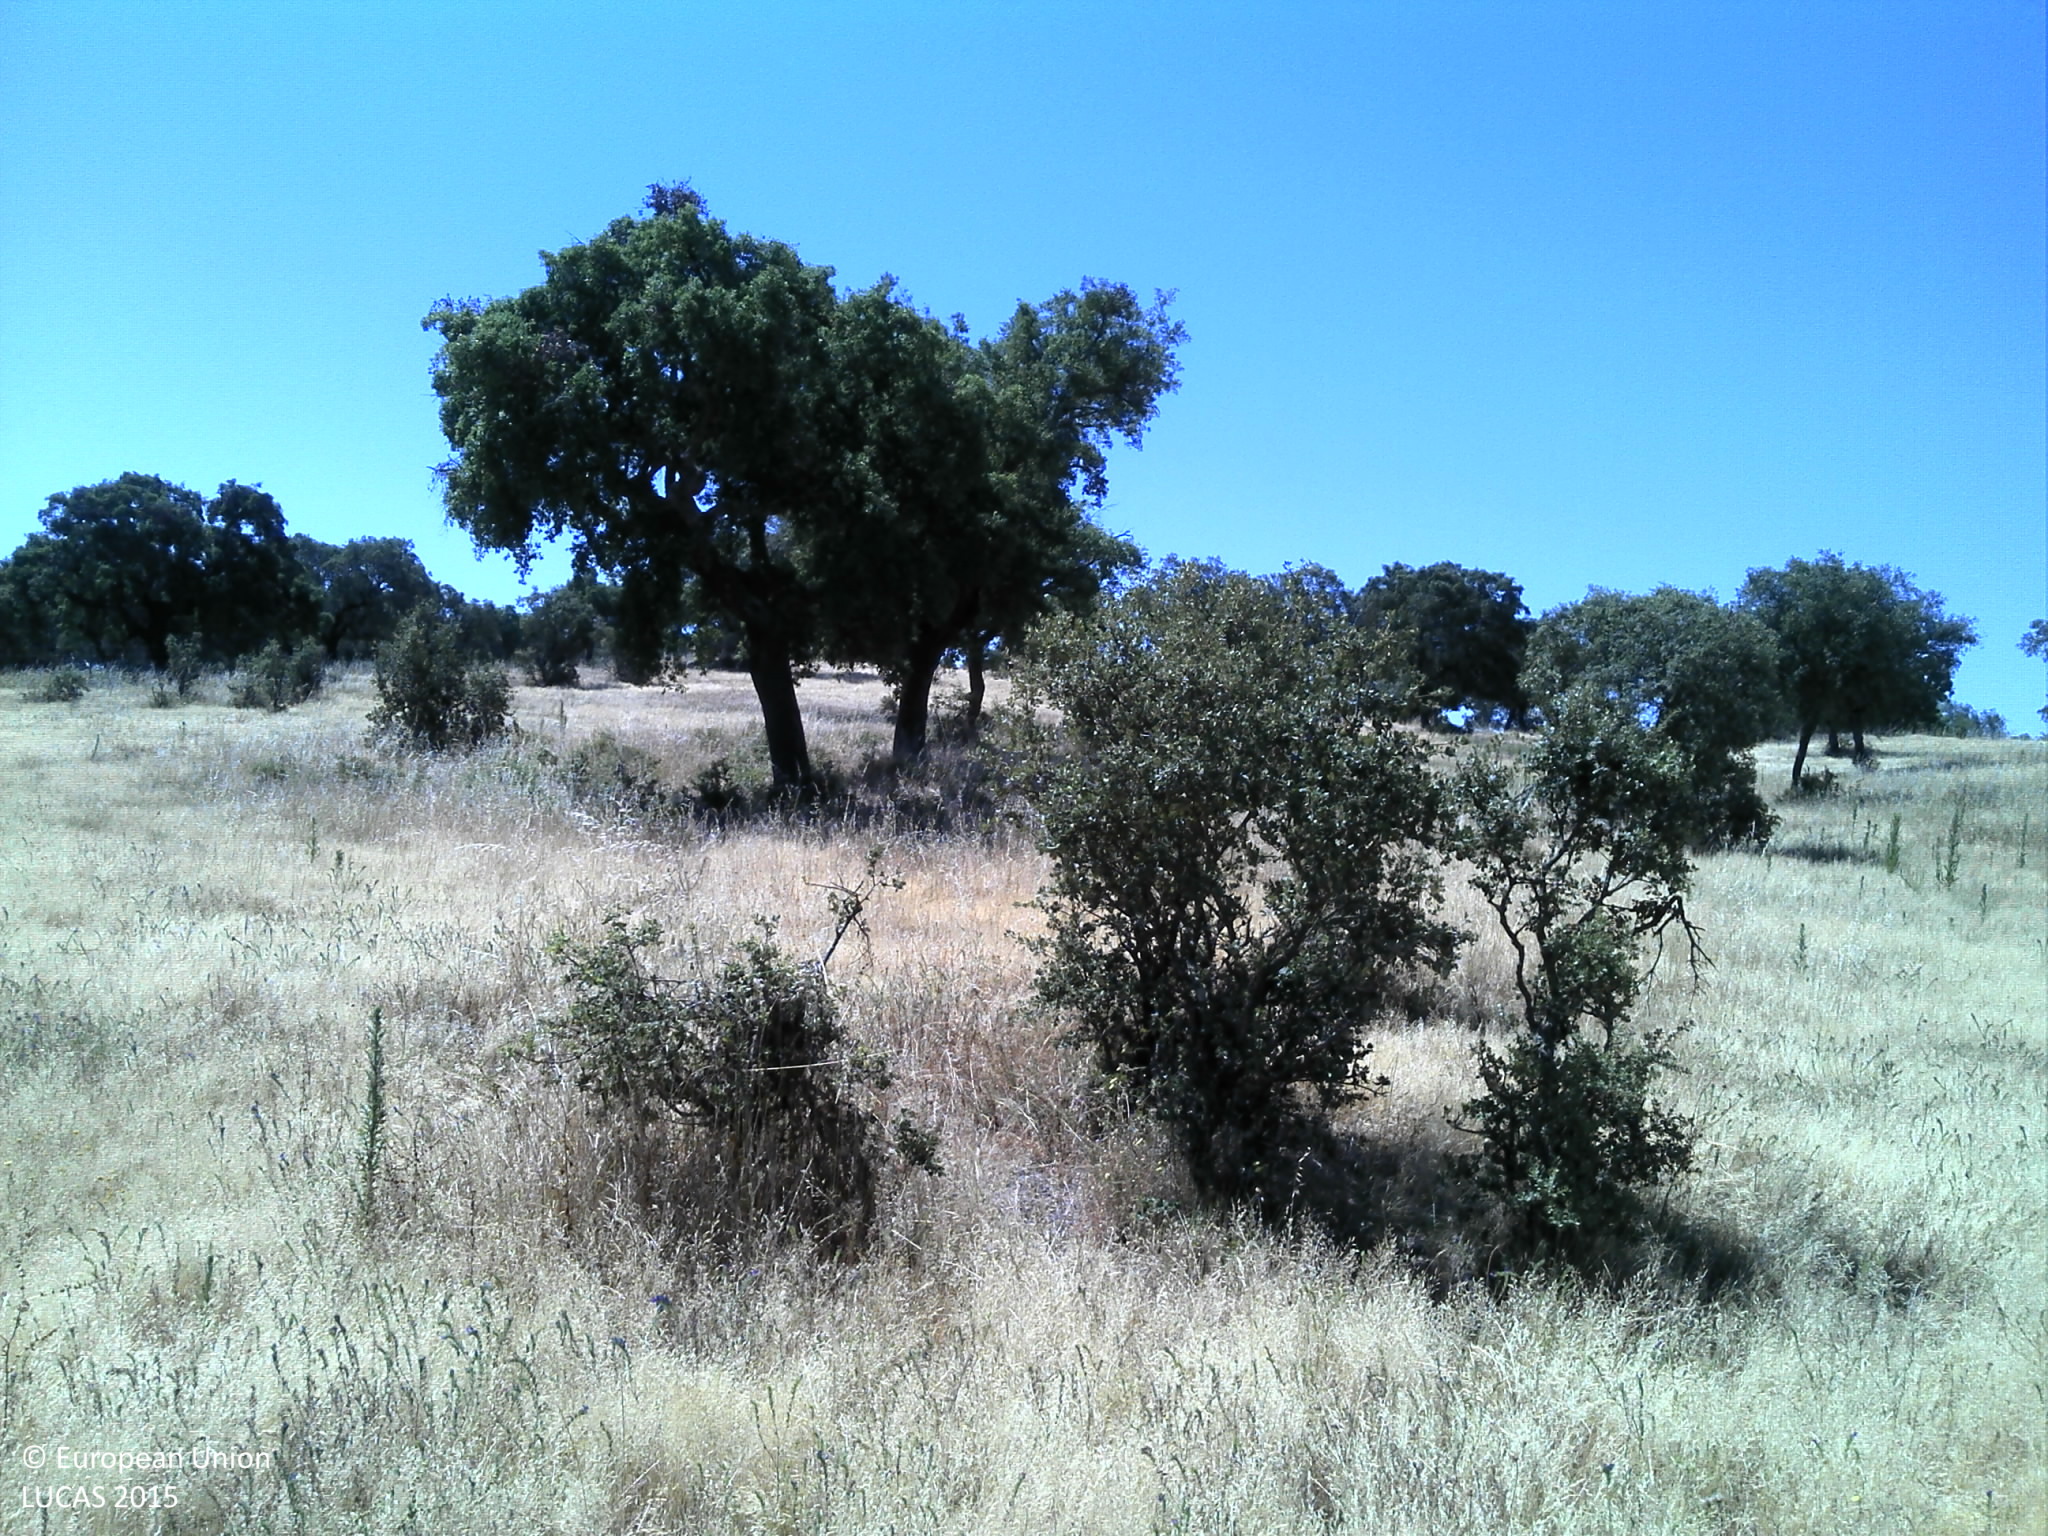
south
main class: Grassland
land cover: Grassland with sparse tree/shrub cover
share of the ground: 25 - 50 %
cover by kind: herbaceous plants 90 %, broadleaved forest trees 5 %, unconsolidated bare surface 5 %
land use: Agriculture (excluding fallow land and kitchen gardens)
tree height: < 5 m
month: June
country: PT
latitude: 38.7353
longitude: -8.1914
